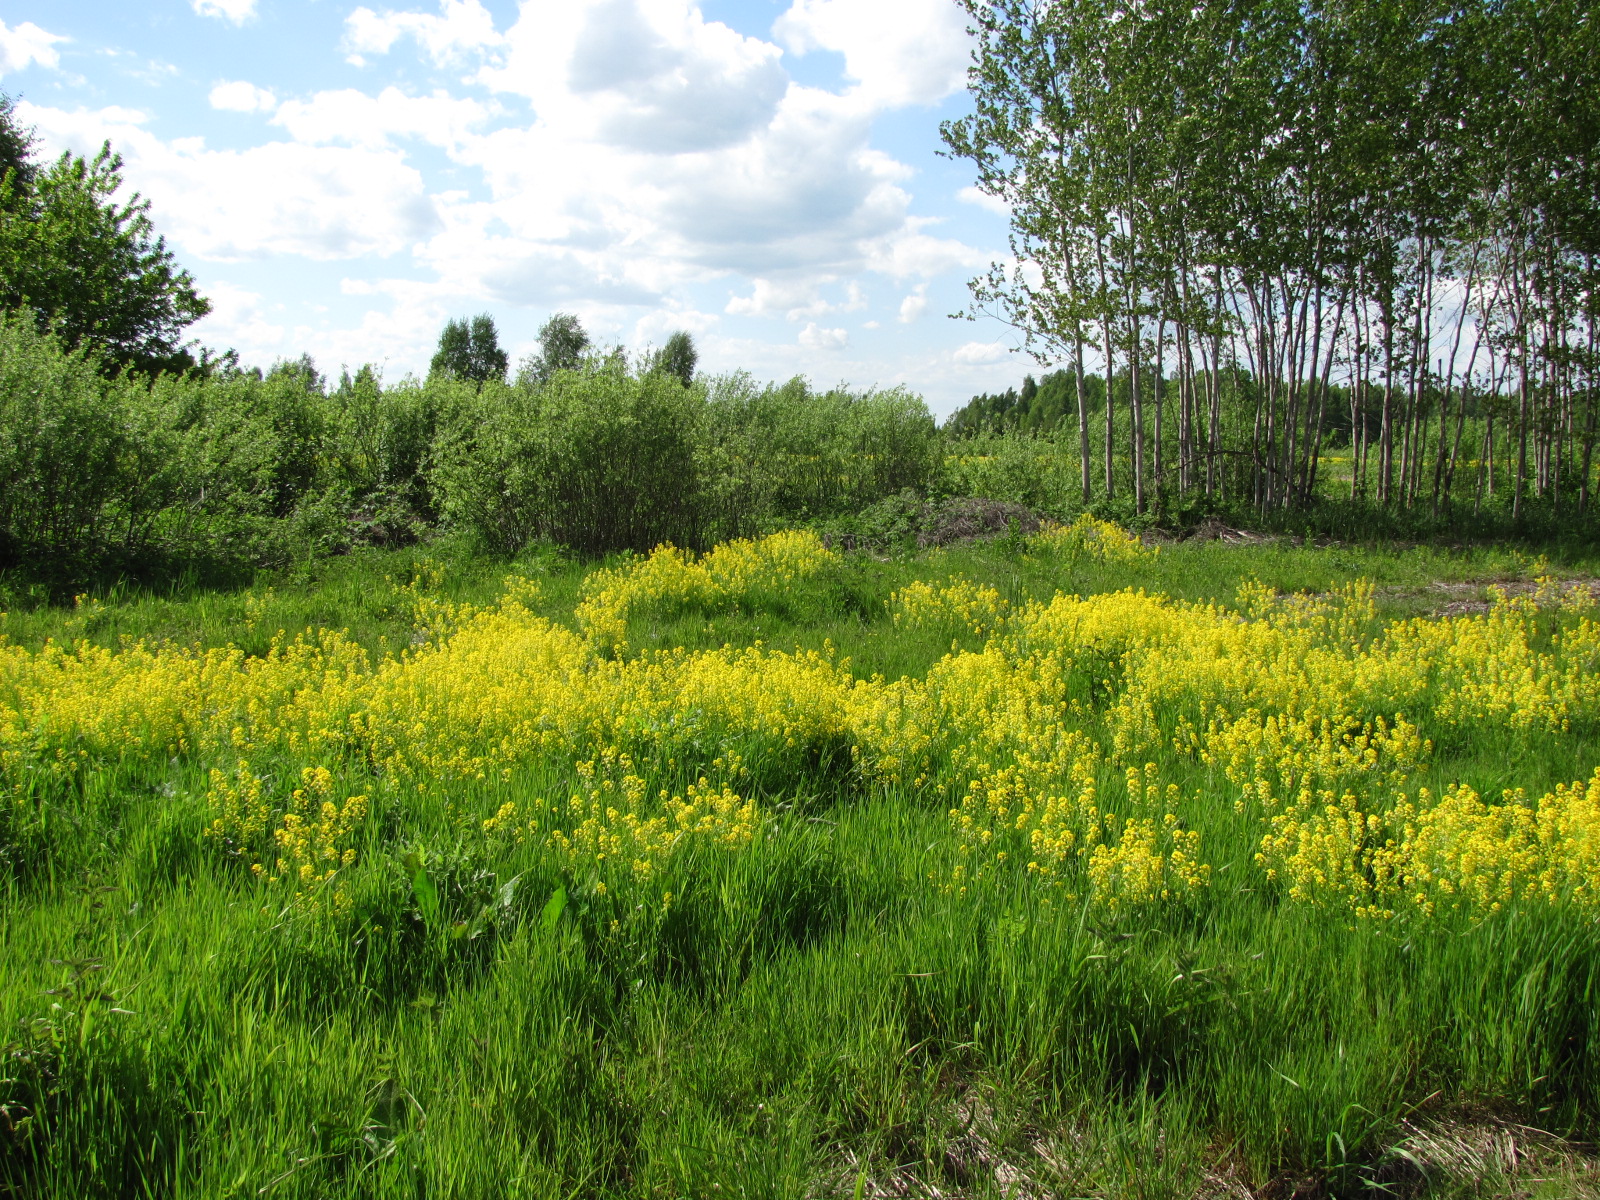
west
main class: Grassland
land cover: Grassland without tree/shrub cover
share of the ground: > 75 %
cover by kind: herbaceous plants 95 %, unconsolidated bare surface 5 %
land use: Agriculture (excluding fallow land and kitchen gardens)
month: May
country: LV
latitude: 56.6373
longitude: 24.0252
